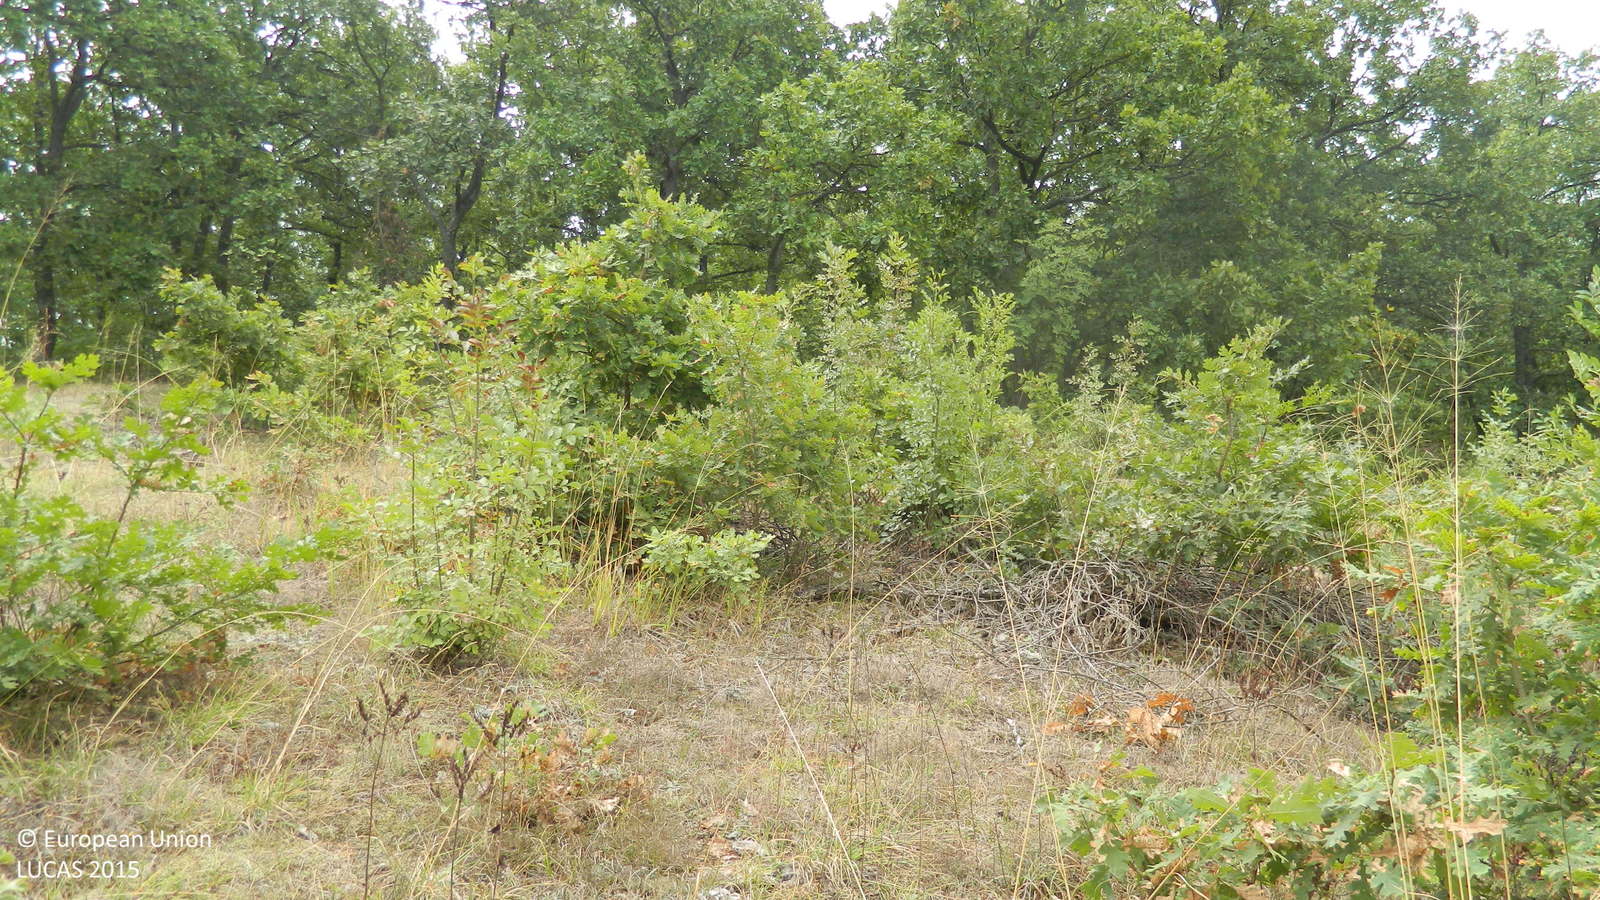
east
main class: Woodland
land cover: Broadleaved woodland
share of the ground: > 75 %
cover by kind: broadleaved forest trees 90 %, herbaceous plants 10 %
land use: Forestry
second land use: Electricity, gas and thermal power distribution
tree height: < 5 m
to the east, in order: Broadleaved woodland; Electric lines; Broadleaved woodland; Rivers and streams; Broadleaved woodland; Tracks; Broadleaved woodland; Grassland with sparse tree/shrub cover; Broadleaved woodland
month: September
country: BG
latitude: 41.7913
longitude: 25.7952
